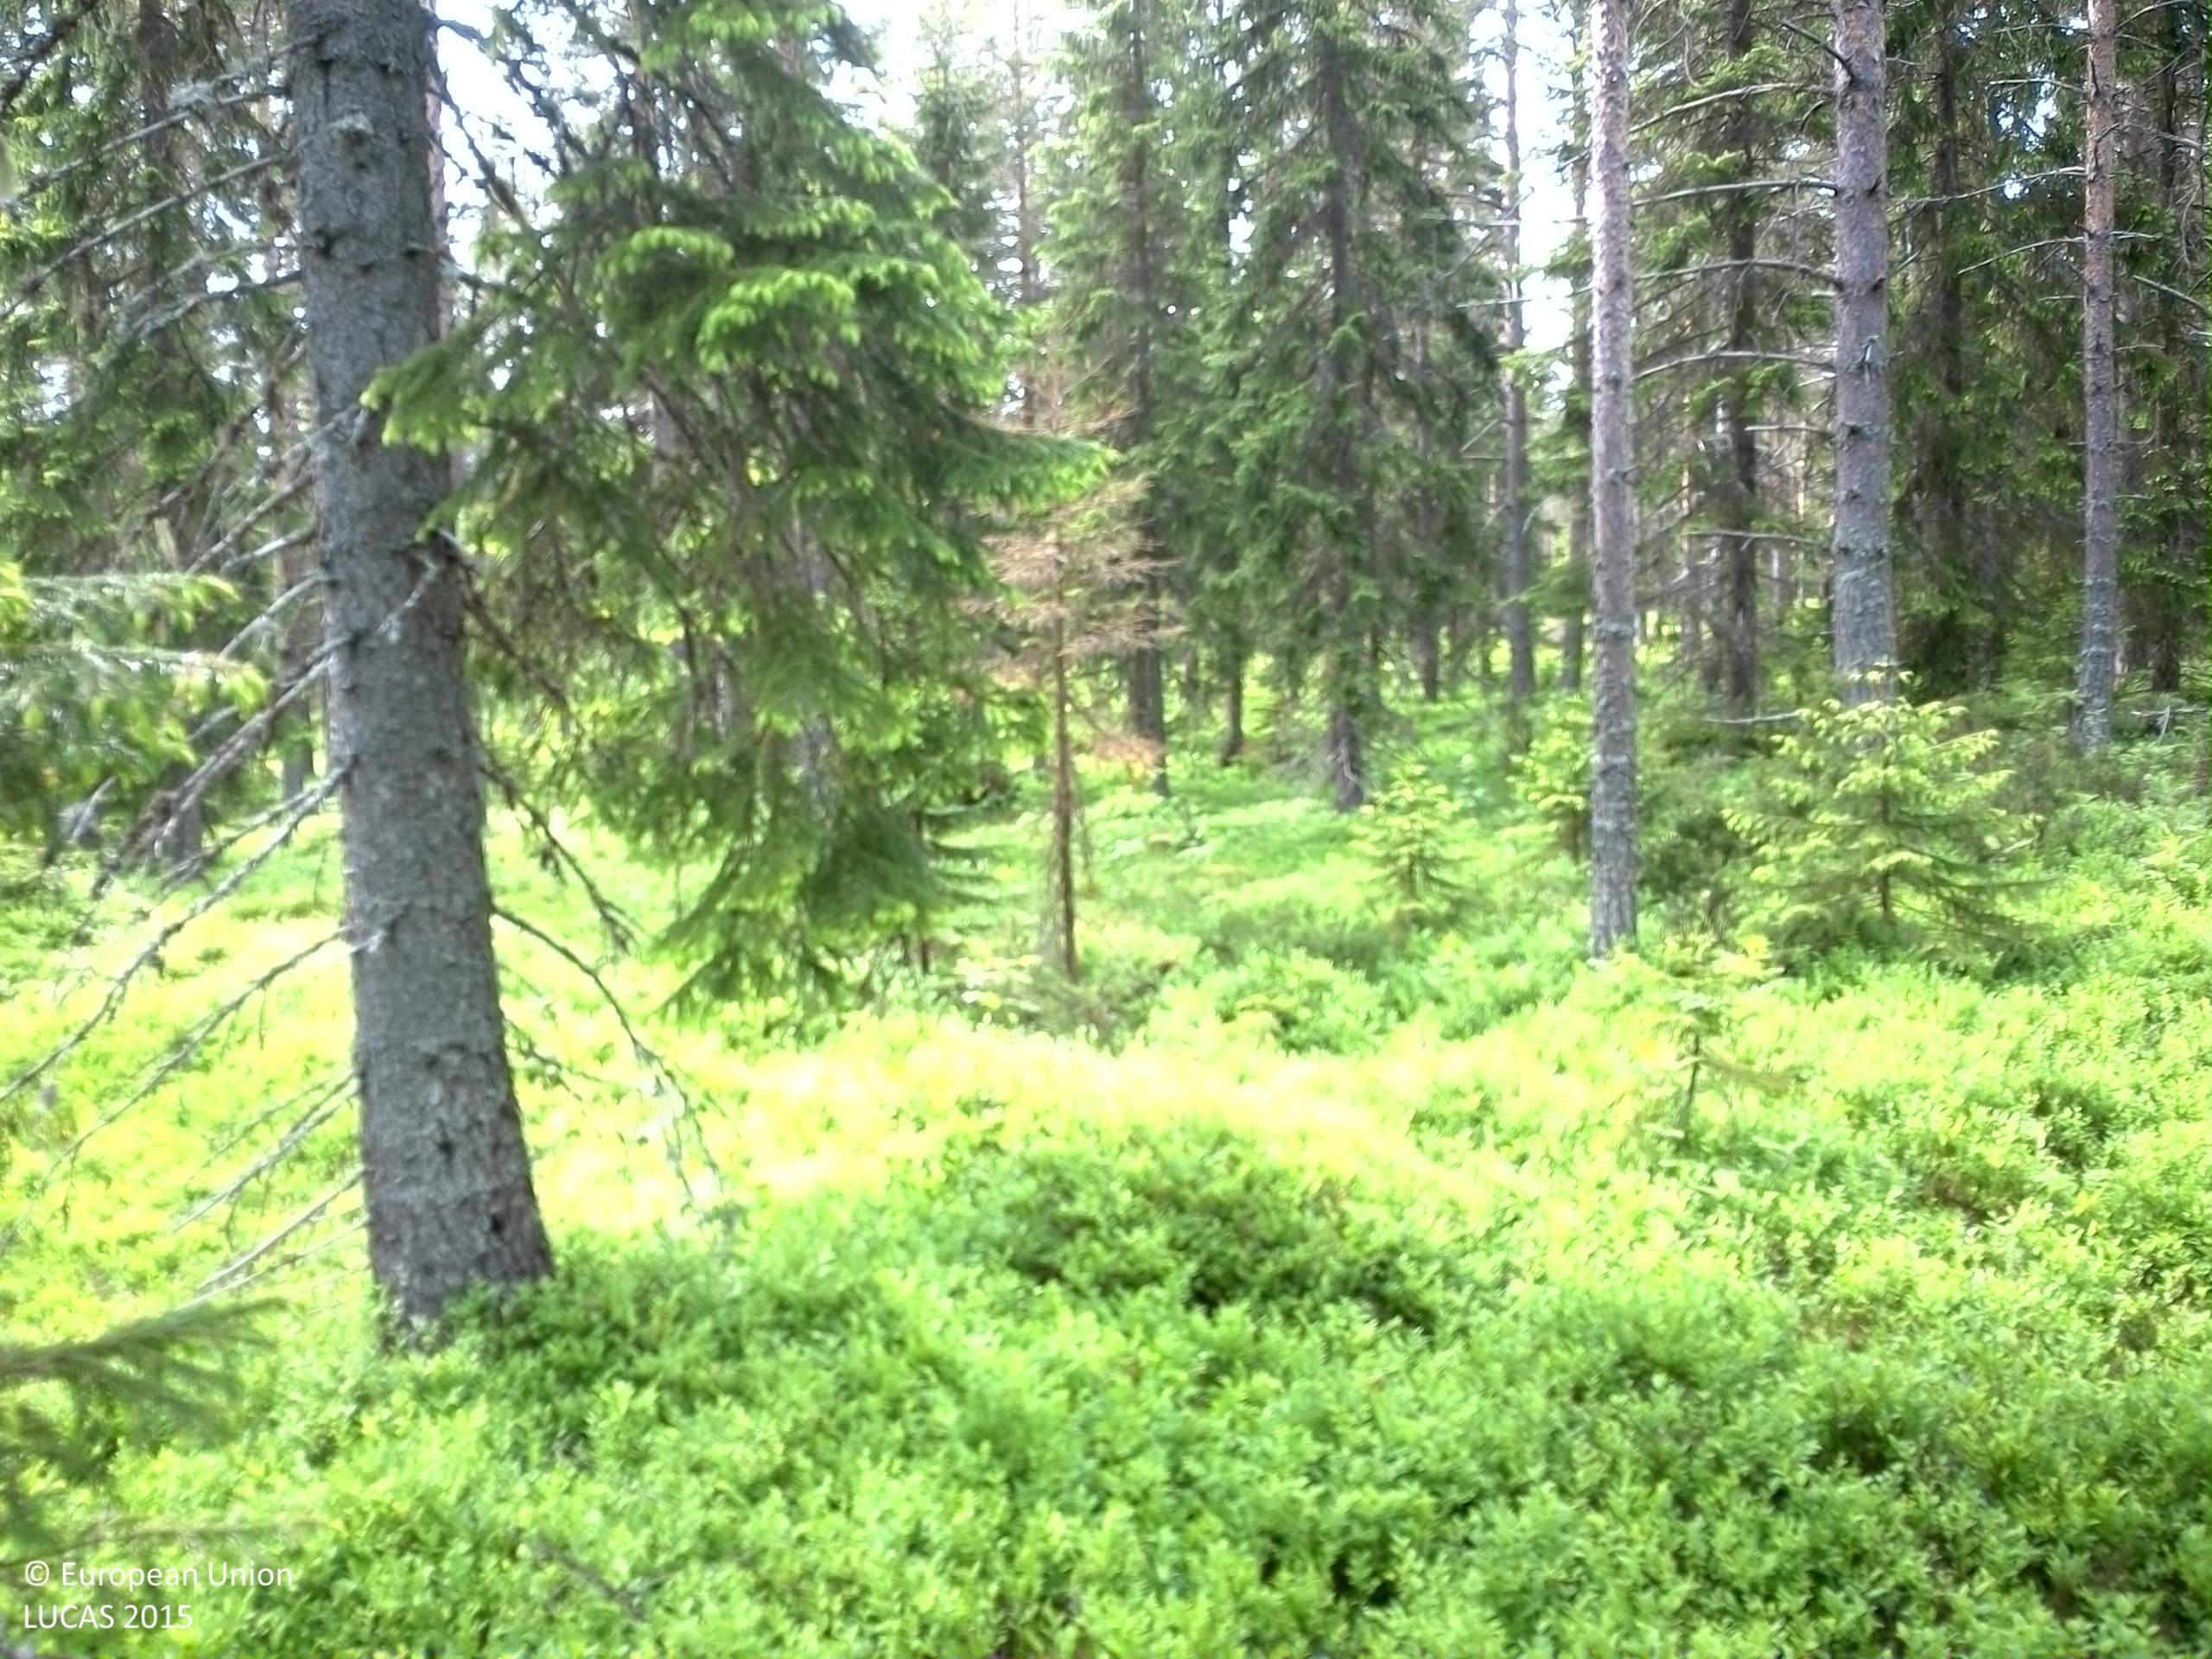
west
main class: Woodland
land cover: Spruce dominated coniferous woodland
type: boreal forest
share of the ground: 50 - 75 %
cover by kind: coniferous forest trees 70 %, shrubs 25 %, broadleaved forest trees 5 %
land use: Forestry
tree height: > 5 m
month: June
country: SE
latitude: 62.7192
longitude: 17.7823
